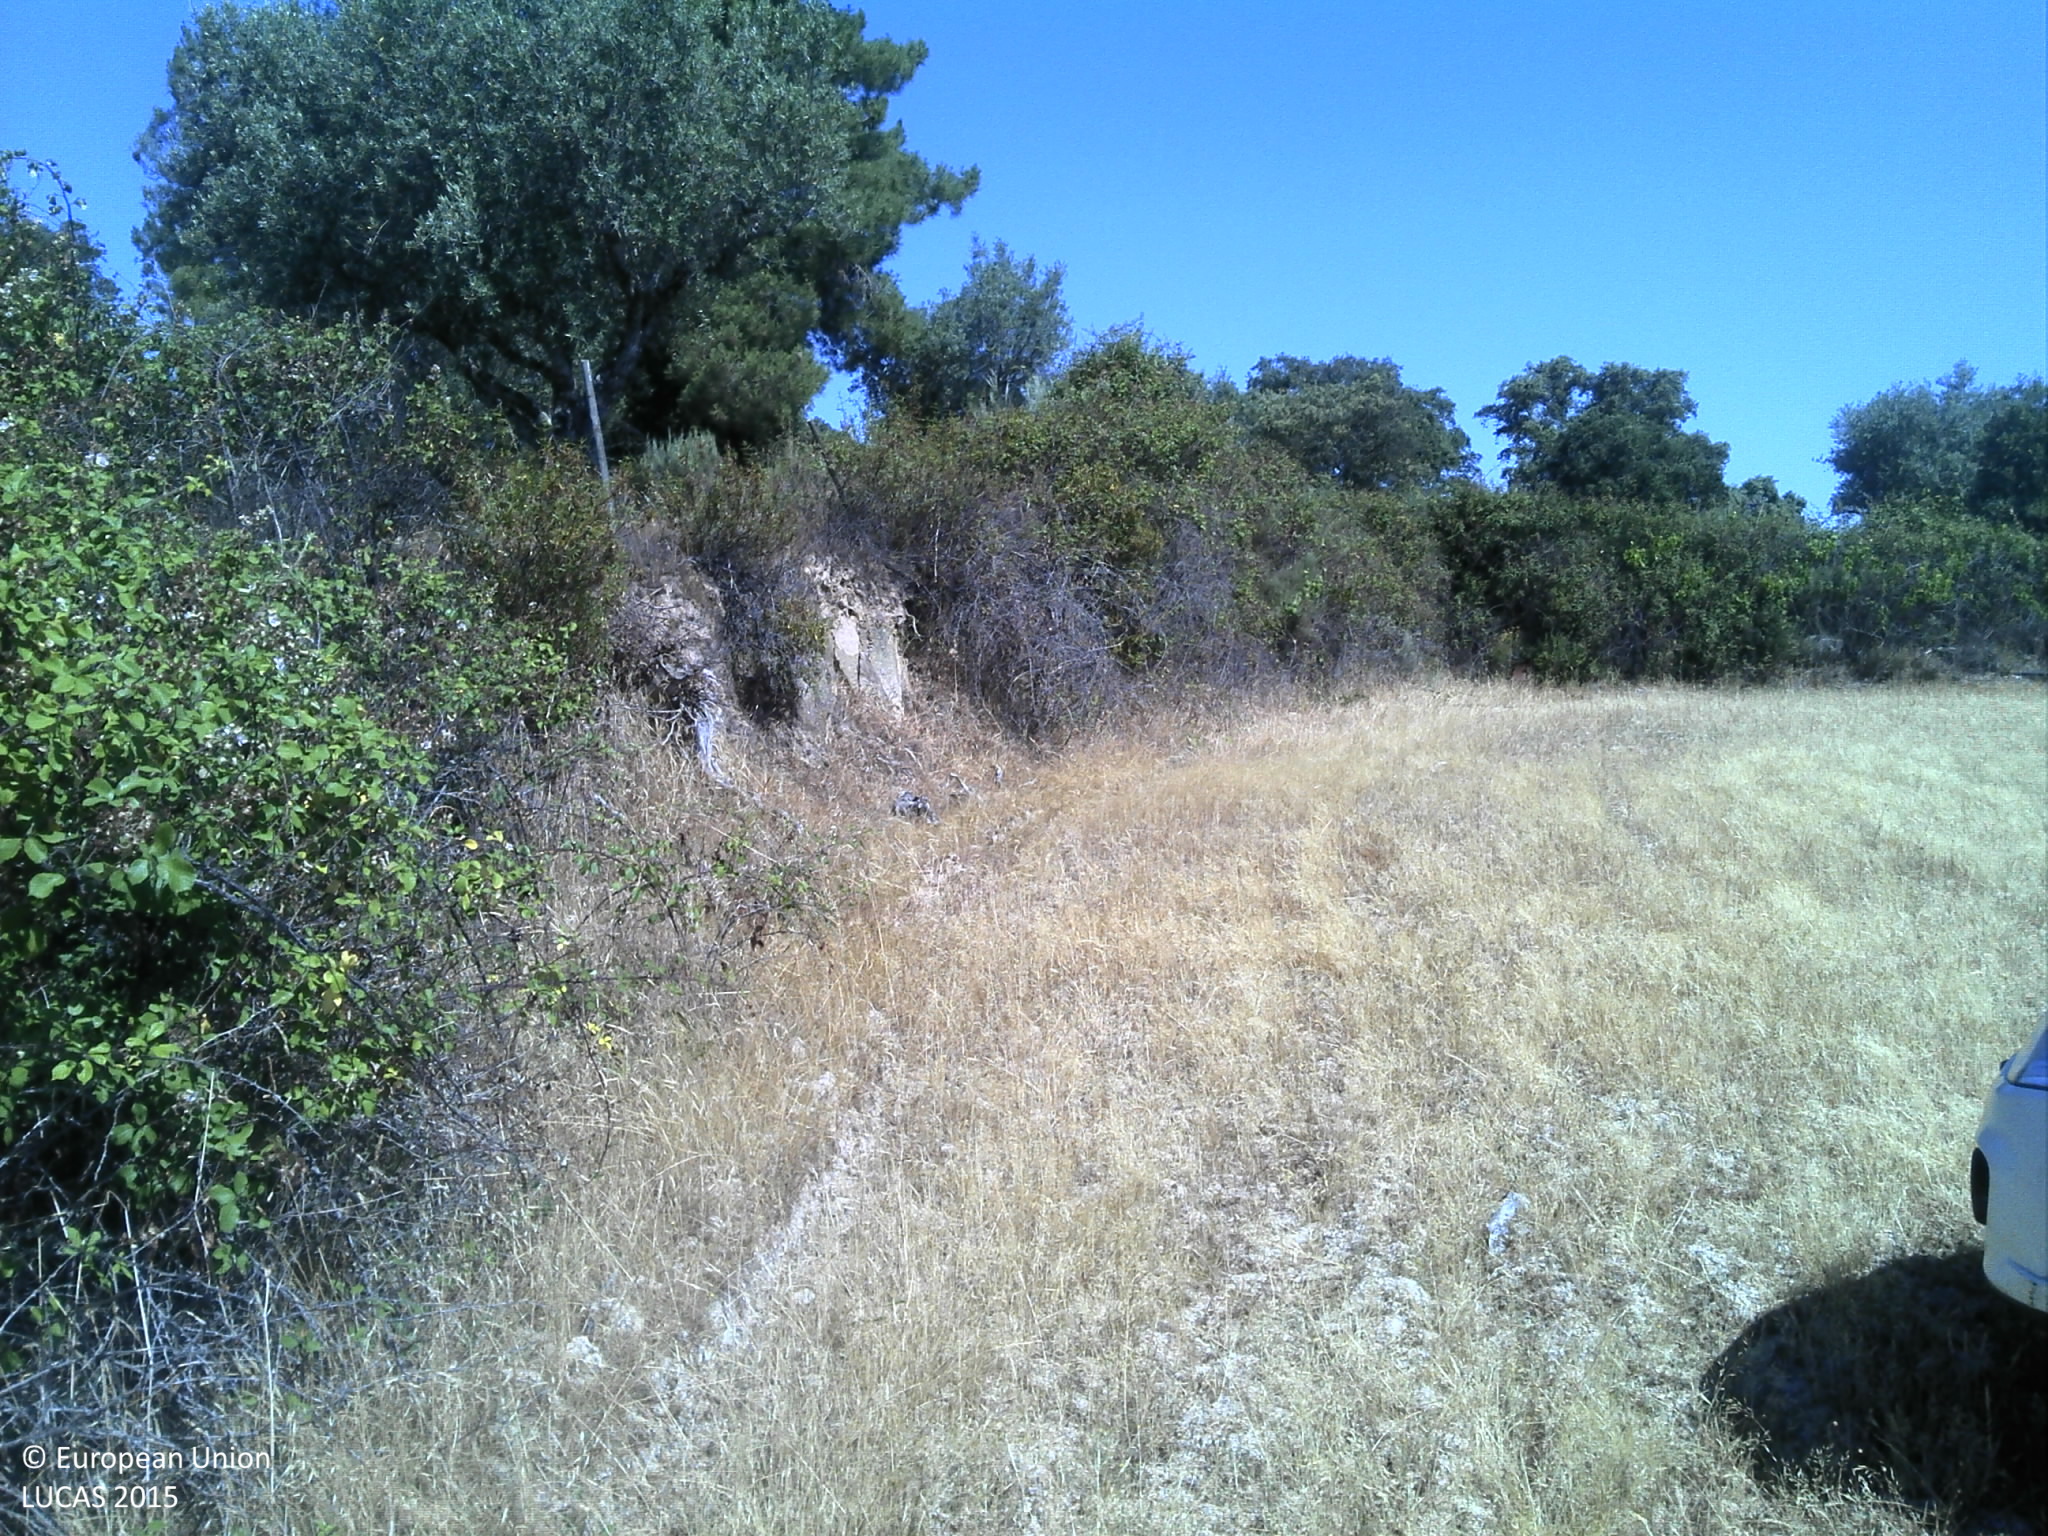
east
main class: Grassland
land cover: Spontaneously vegetated surfaces
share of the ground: 50 - 75 %
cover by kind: herbaceous plants 60 %, unconsolidated bare surface 40 %
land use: Fallow land
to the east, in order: Spontaneously vegetated surfaces; Fences; Dry stone walls; Vineyards; Single bushes/trees; Rivers and streams; Shrubland with sparse tree cover; Abandoned hedges; Olive groves; Dry stone walls; Fences; Tracks; Fences; Dry stone walls; Olive groves; Dry stone walls; Olive groves
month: June
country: PT
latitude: 40.0346
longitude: -7.3619
